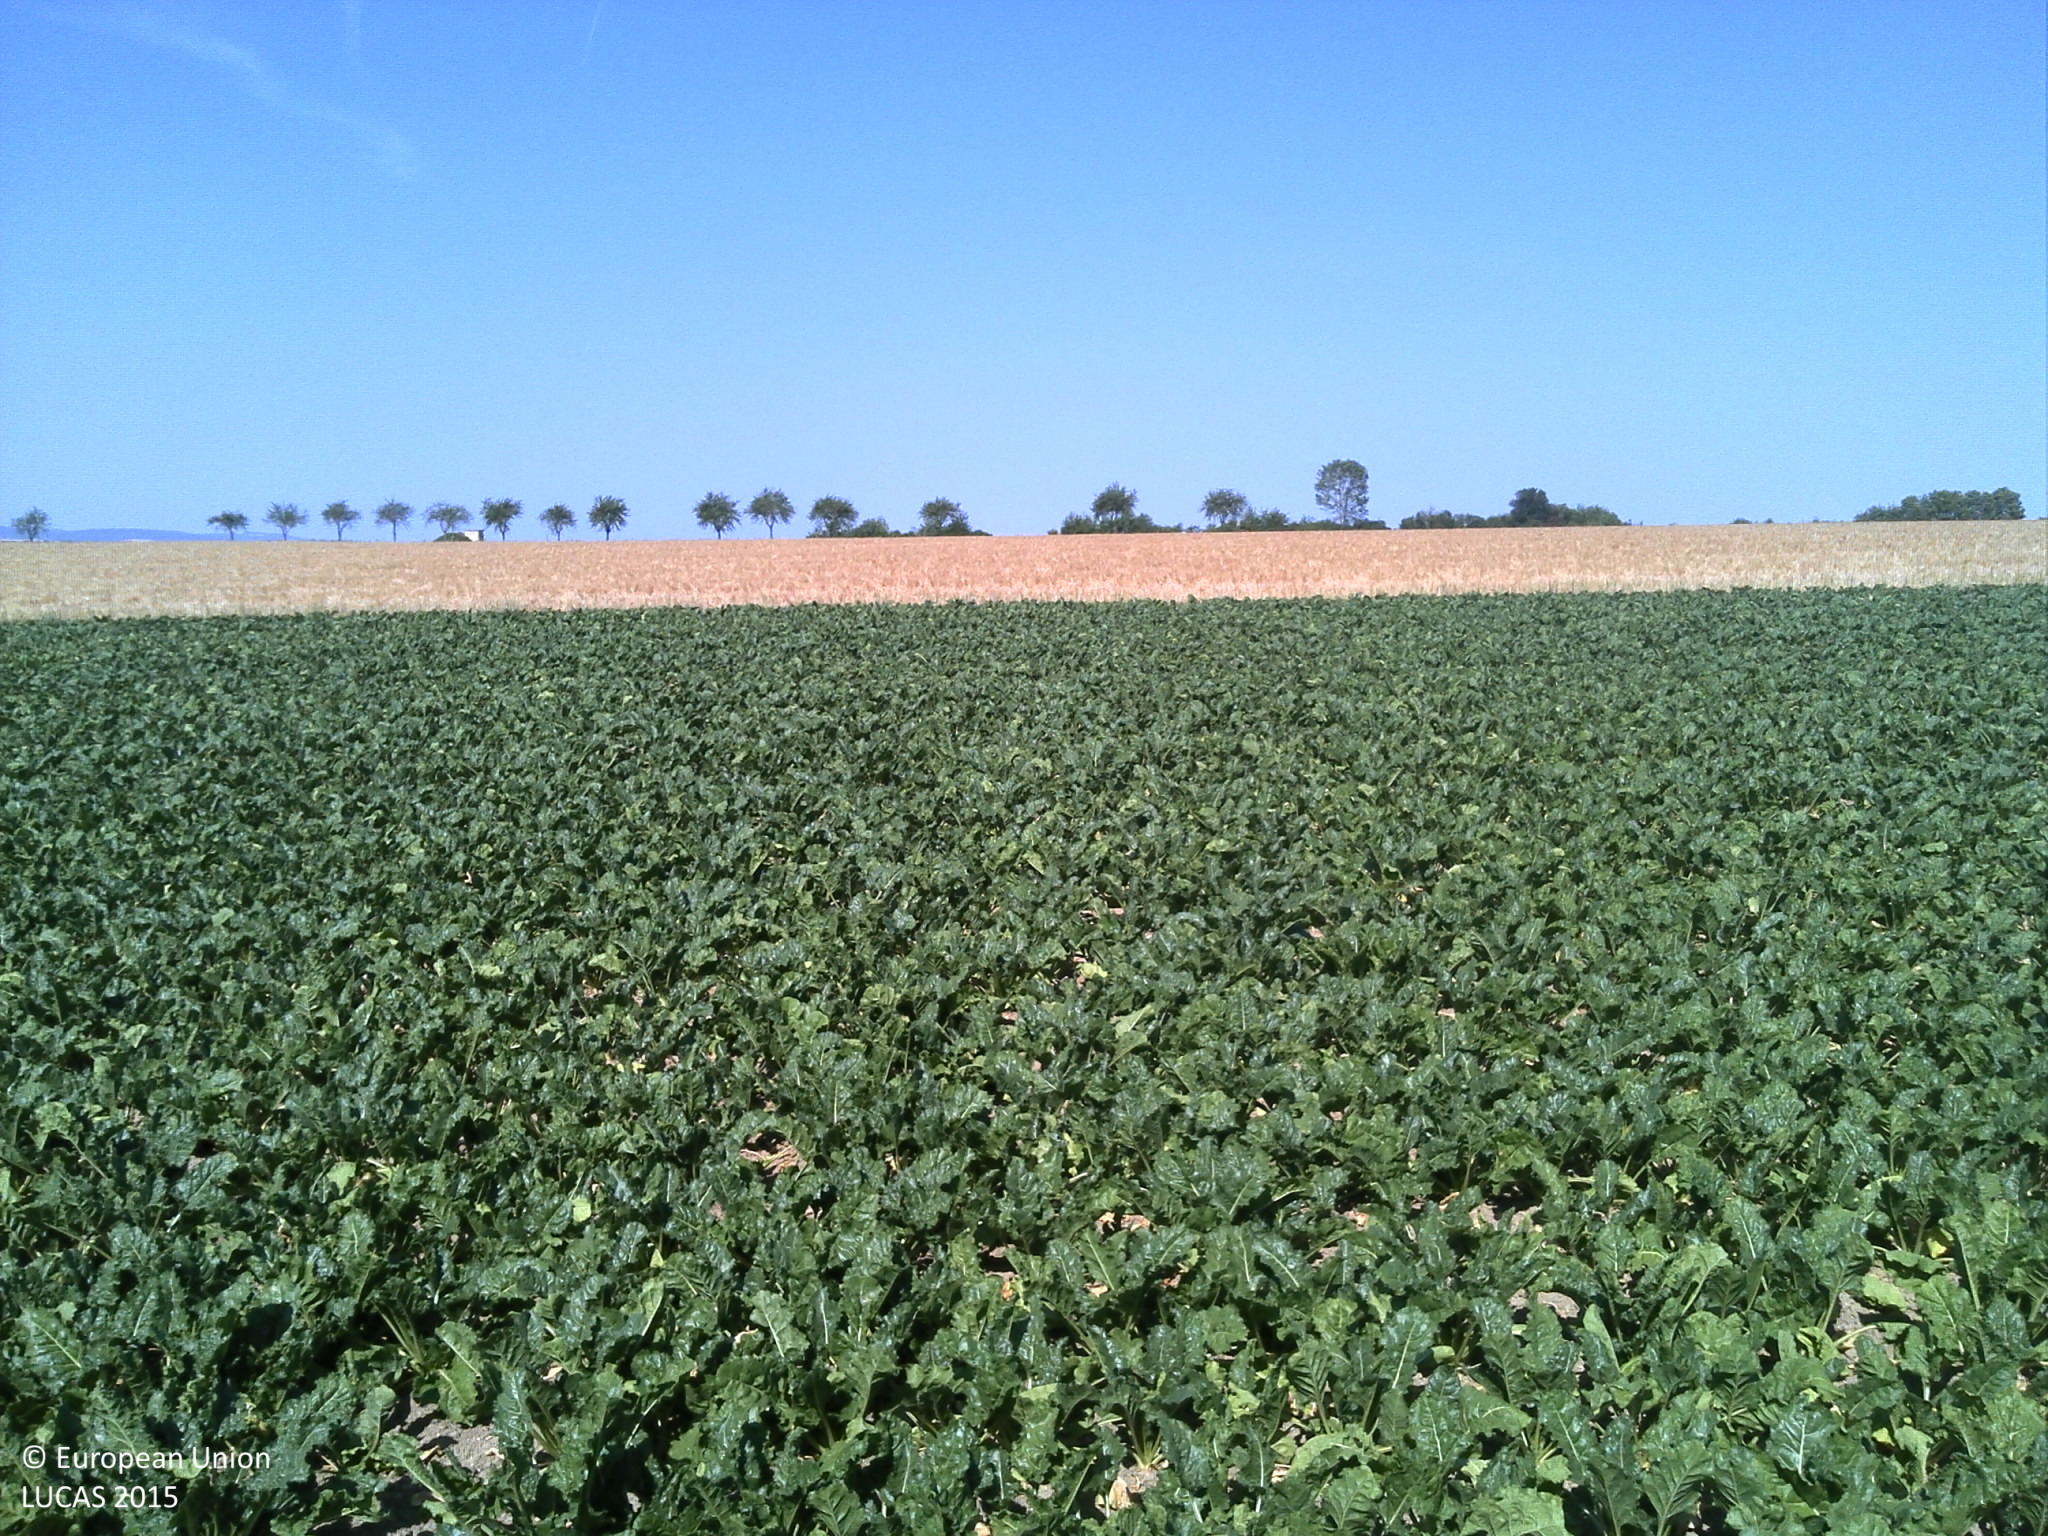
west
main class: Cropland
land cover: Sugar beet
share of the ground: > 75 %
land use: Agriculture (excluding fallow land and kitchen gardens)
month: July
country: FR
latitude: 49.4368
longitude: 4.1067
